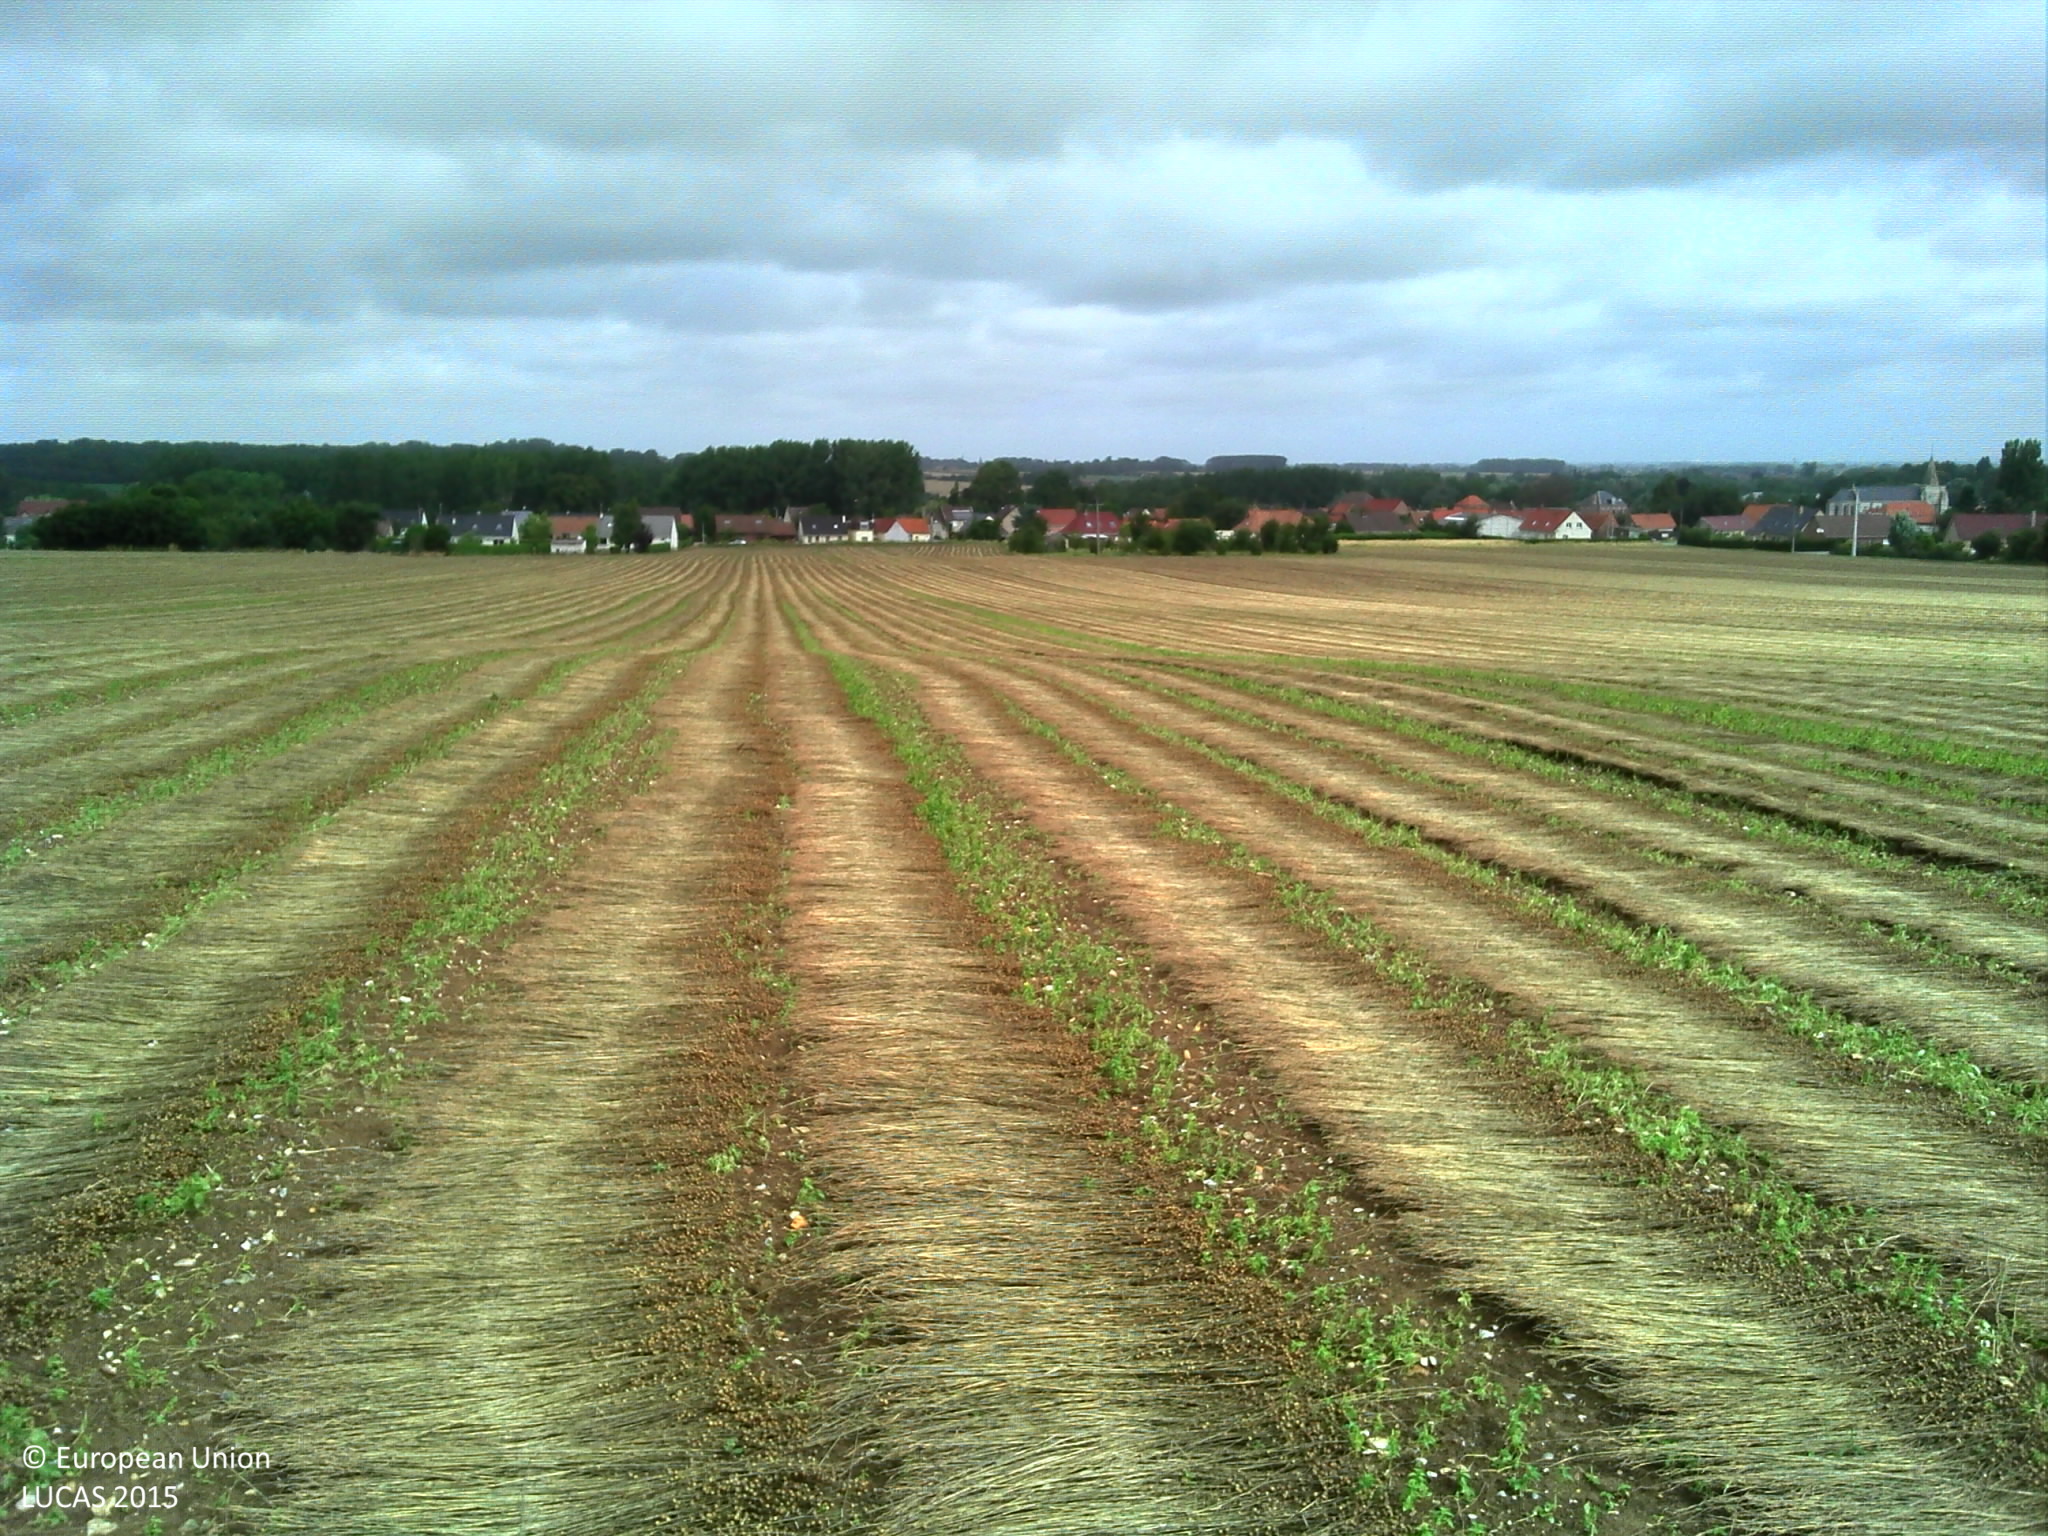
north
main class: Cropland
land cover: Other fibre and oleaginous crops
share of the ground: 50 - 75 %
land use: Agriculture (excluding fallow land and kitchen gardens)
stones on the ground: 10 - 25 %
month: July
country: FR
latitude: 50.8119
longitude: 2.0796
